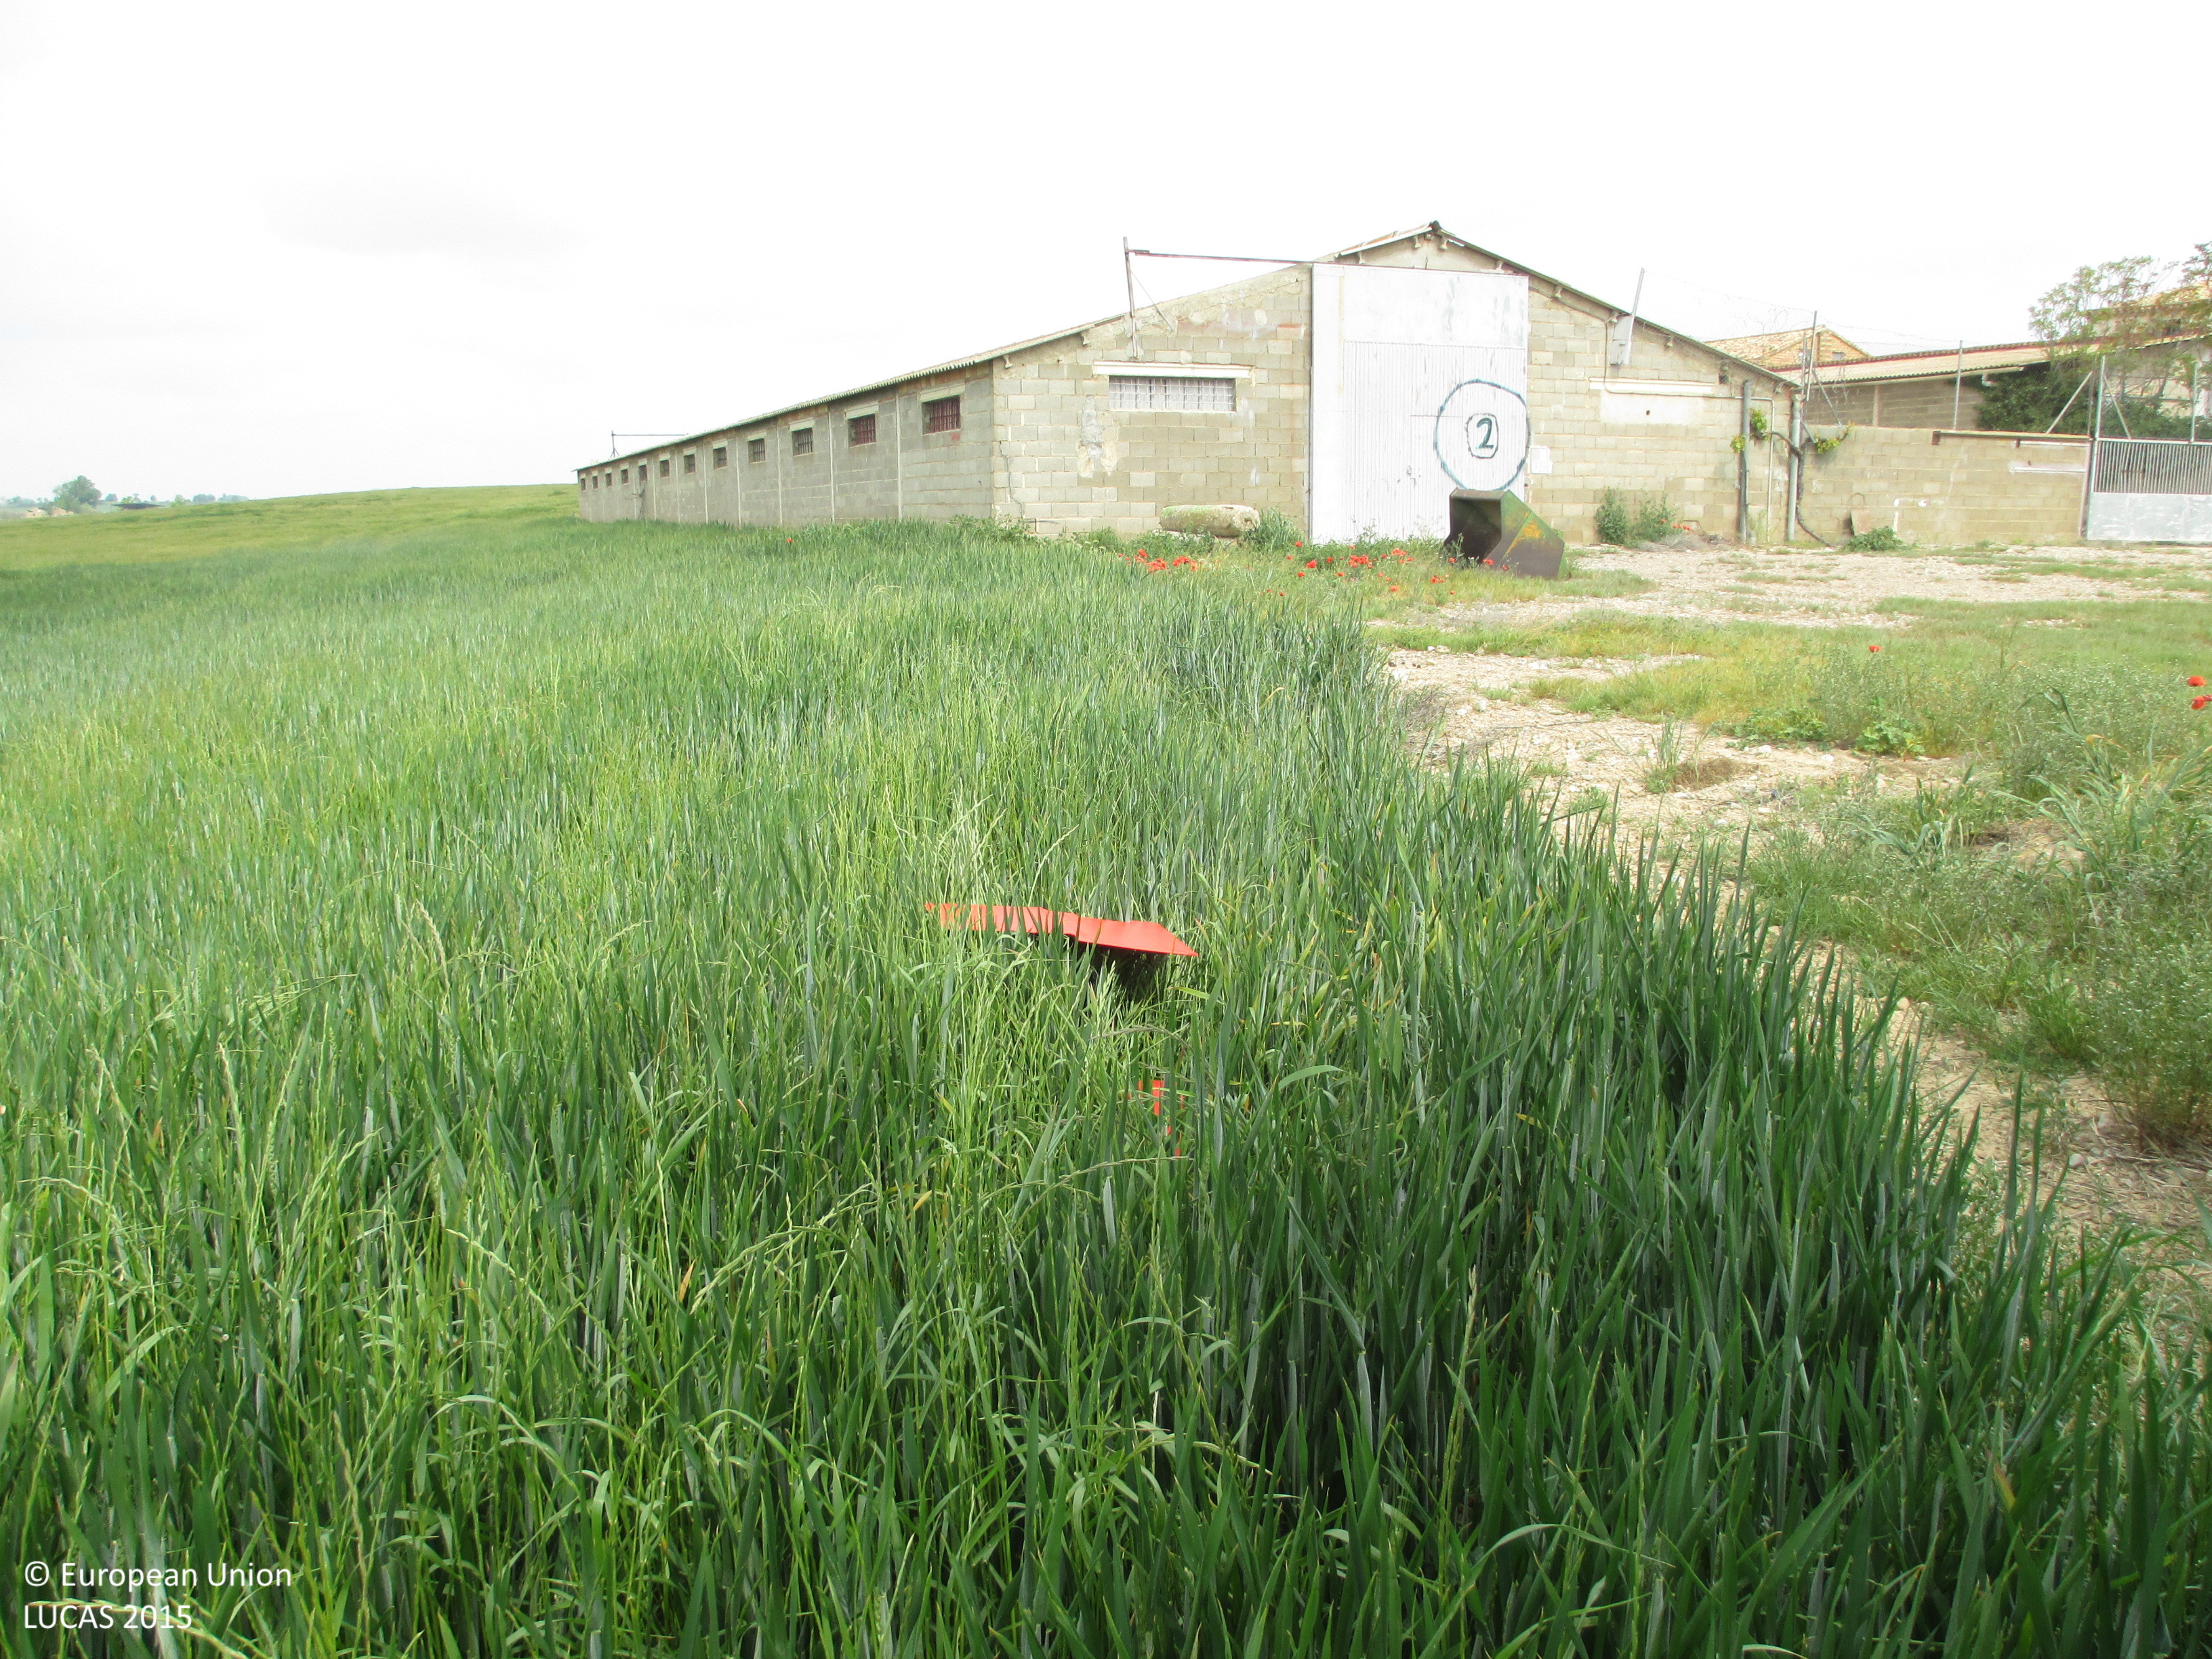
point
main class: Cropland
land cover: Durum wheat
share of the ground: > 75 %
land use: Agriculture (excluding fallow land and kitchen gardens)
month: April
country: ES
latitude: 42.0981
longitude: -0.4087
